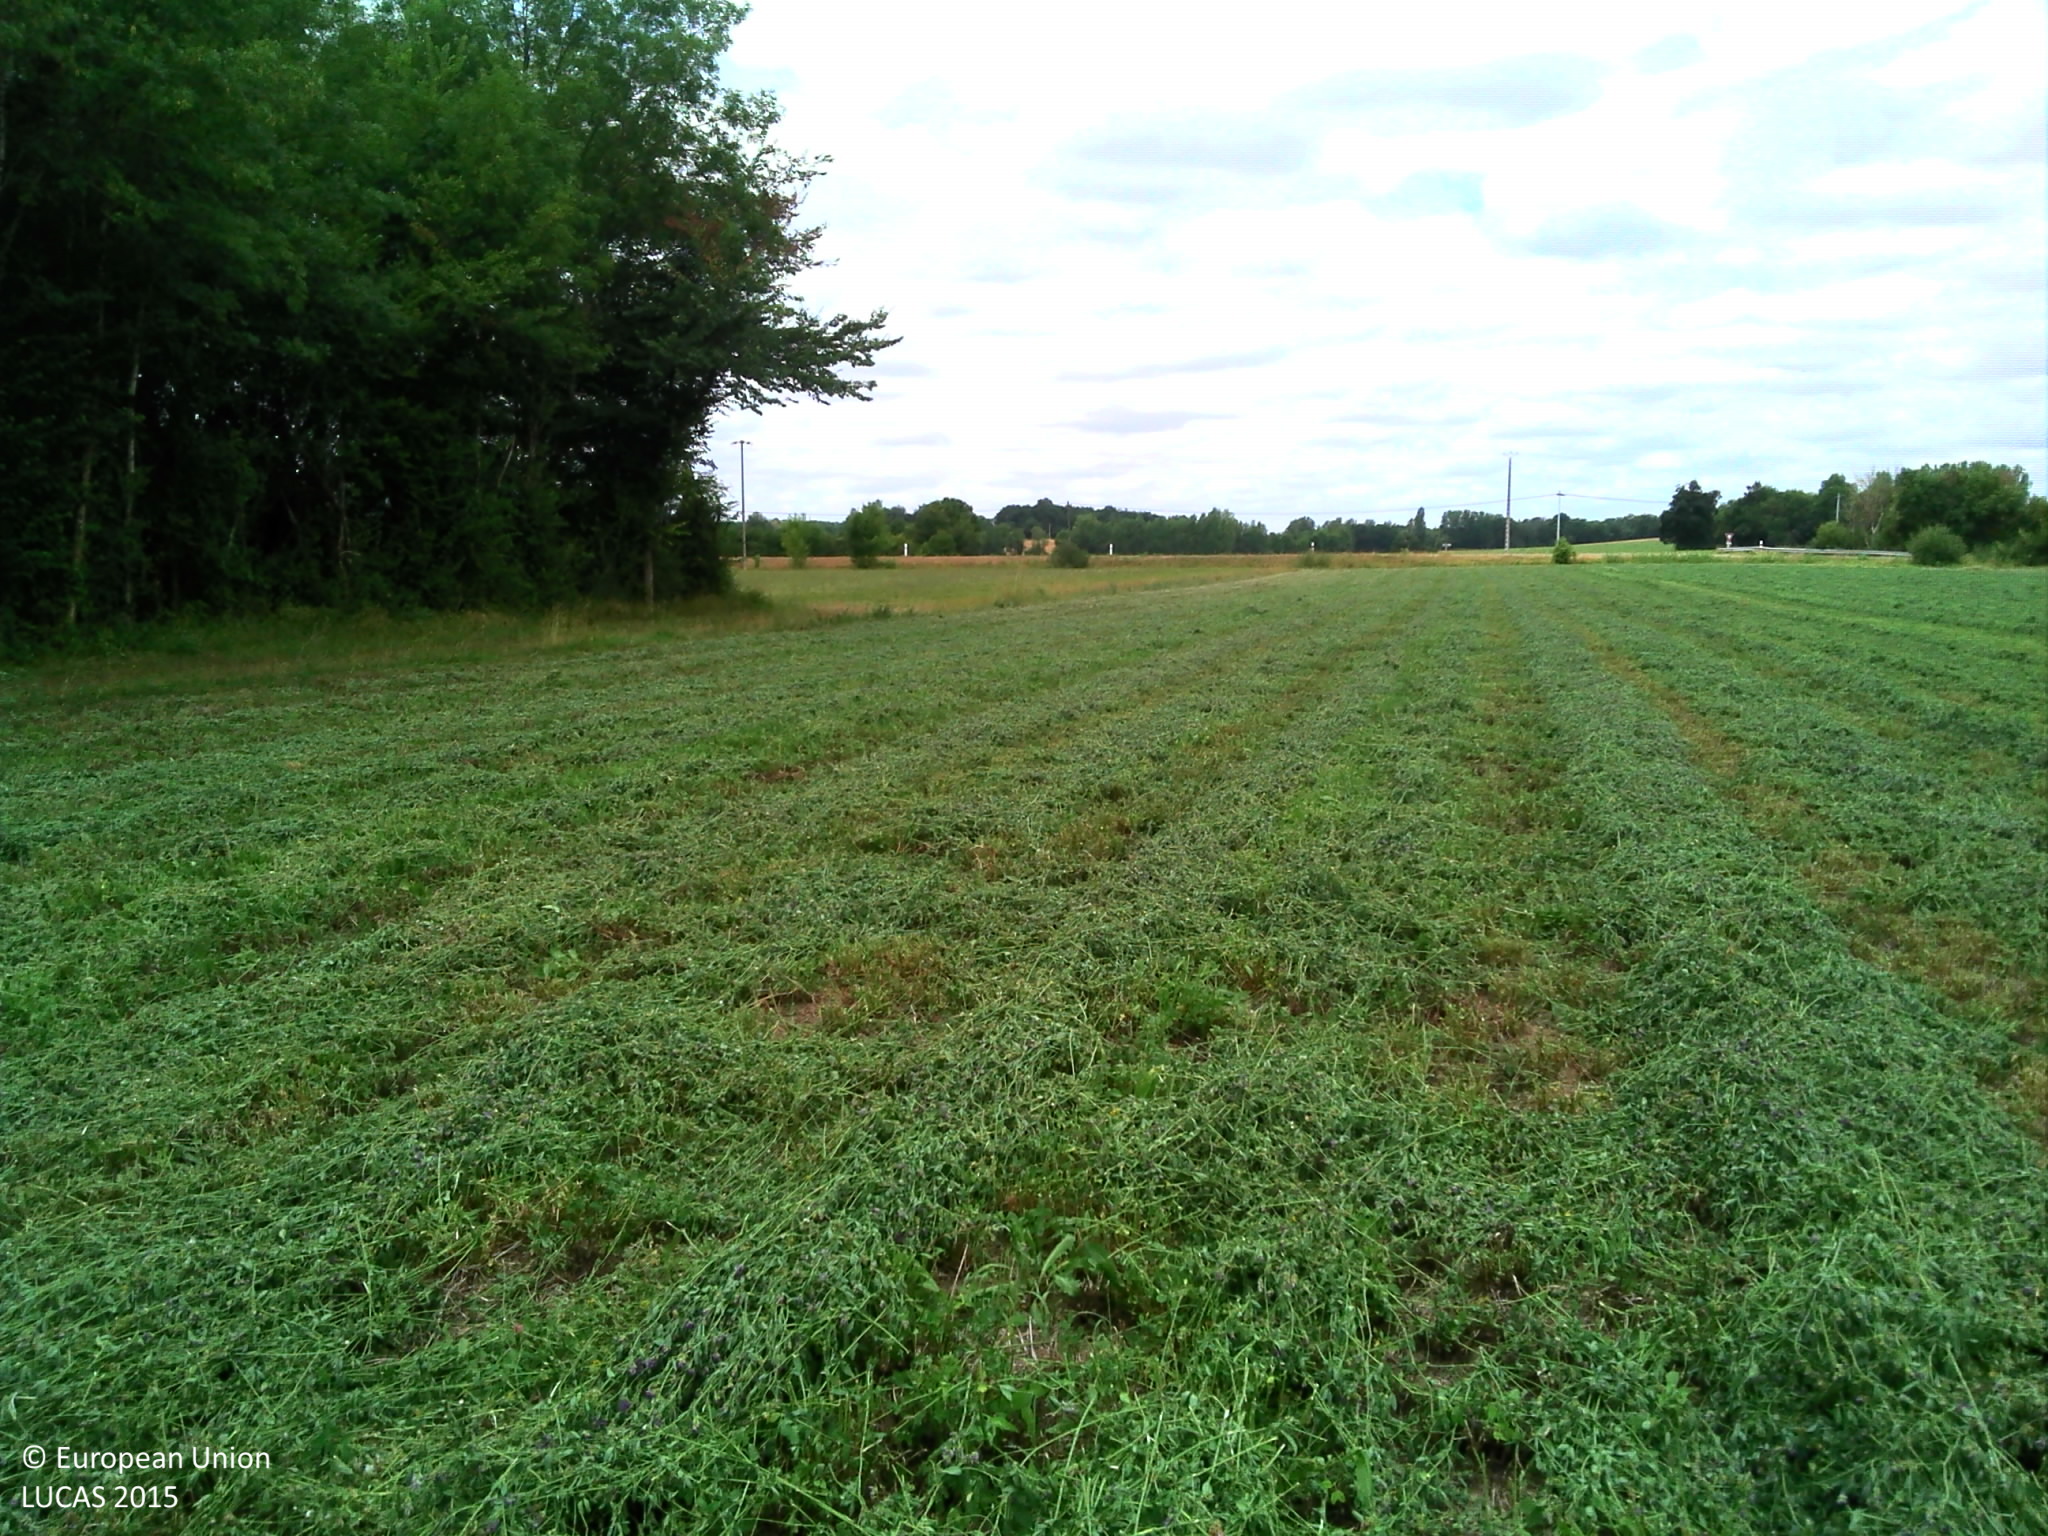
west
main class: Cropland
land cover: Lucerne
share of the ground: > 75 %
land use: Agriculture (excluding fallow land and kitchen gardens)
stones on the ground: < 10 %
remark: Harvested field
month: July
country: FR
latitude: 44.6644
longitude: 0.7734
